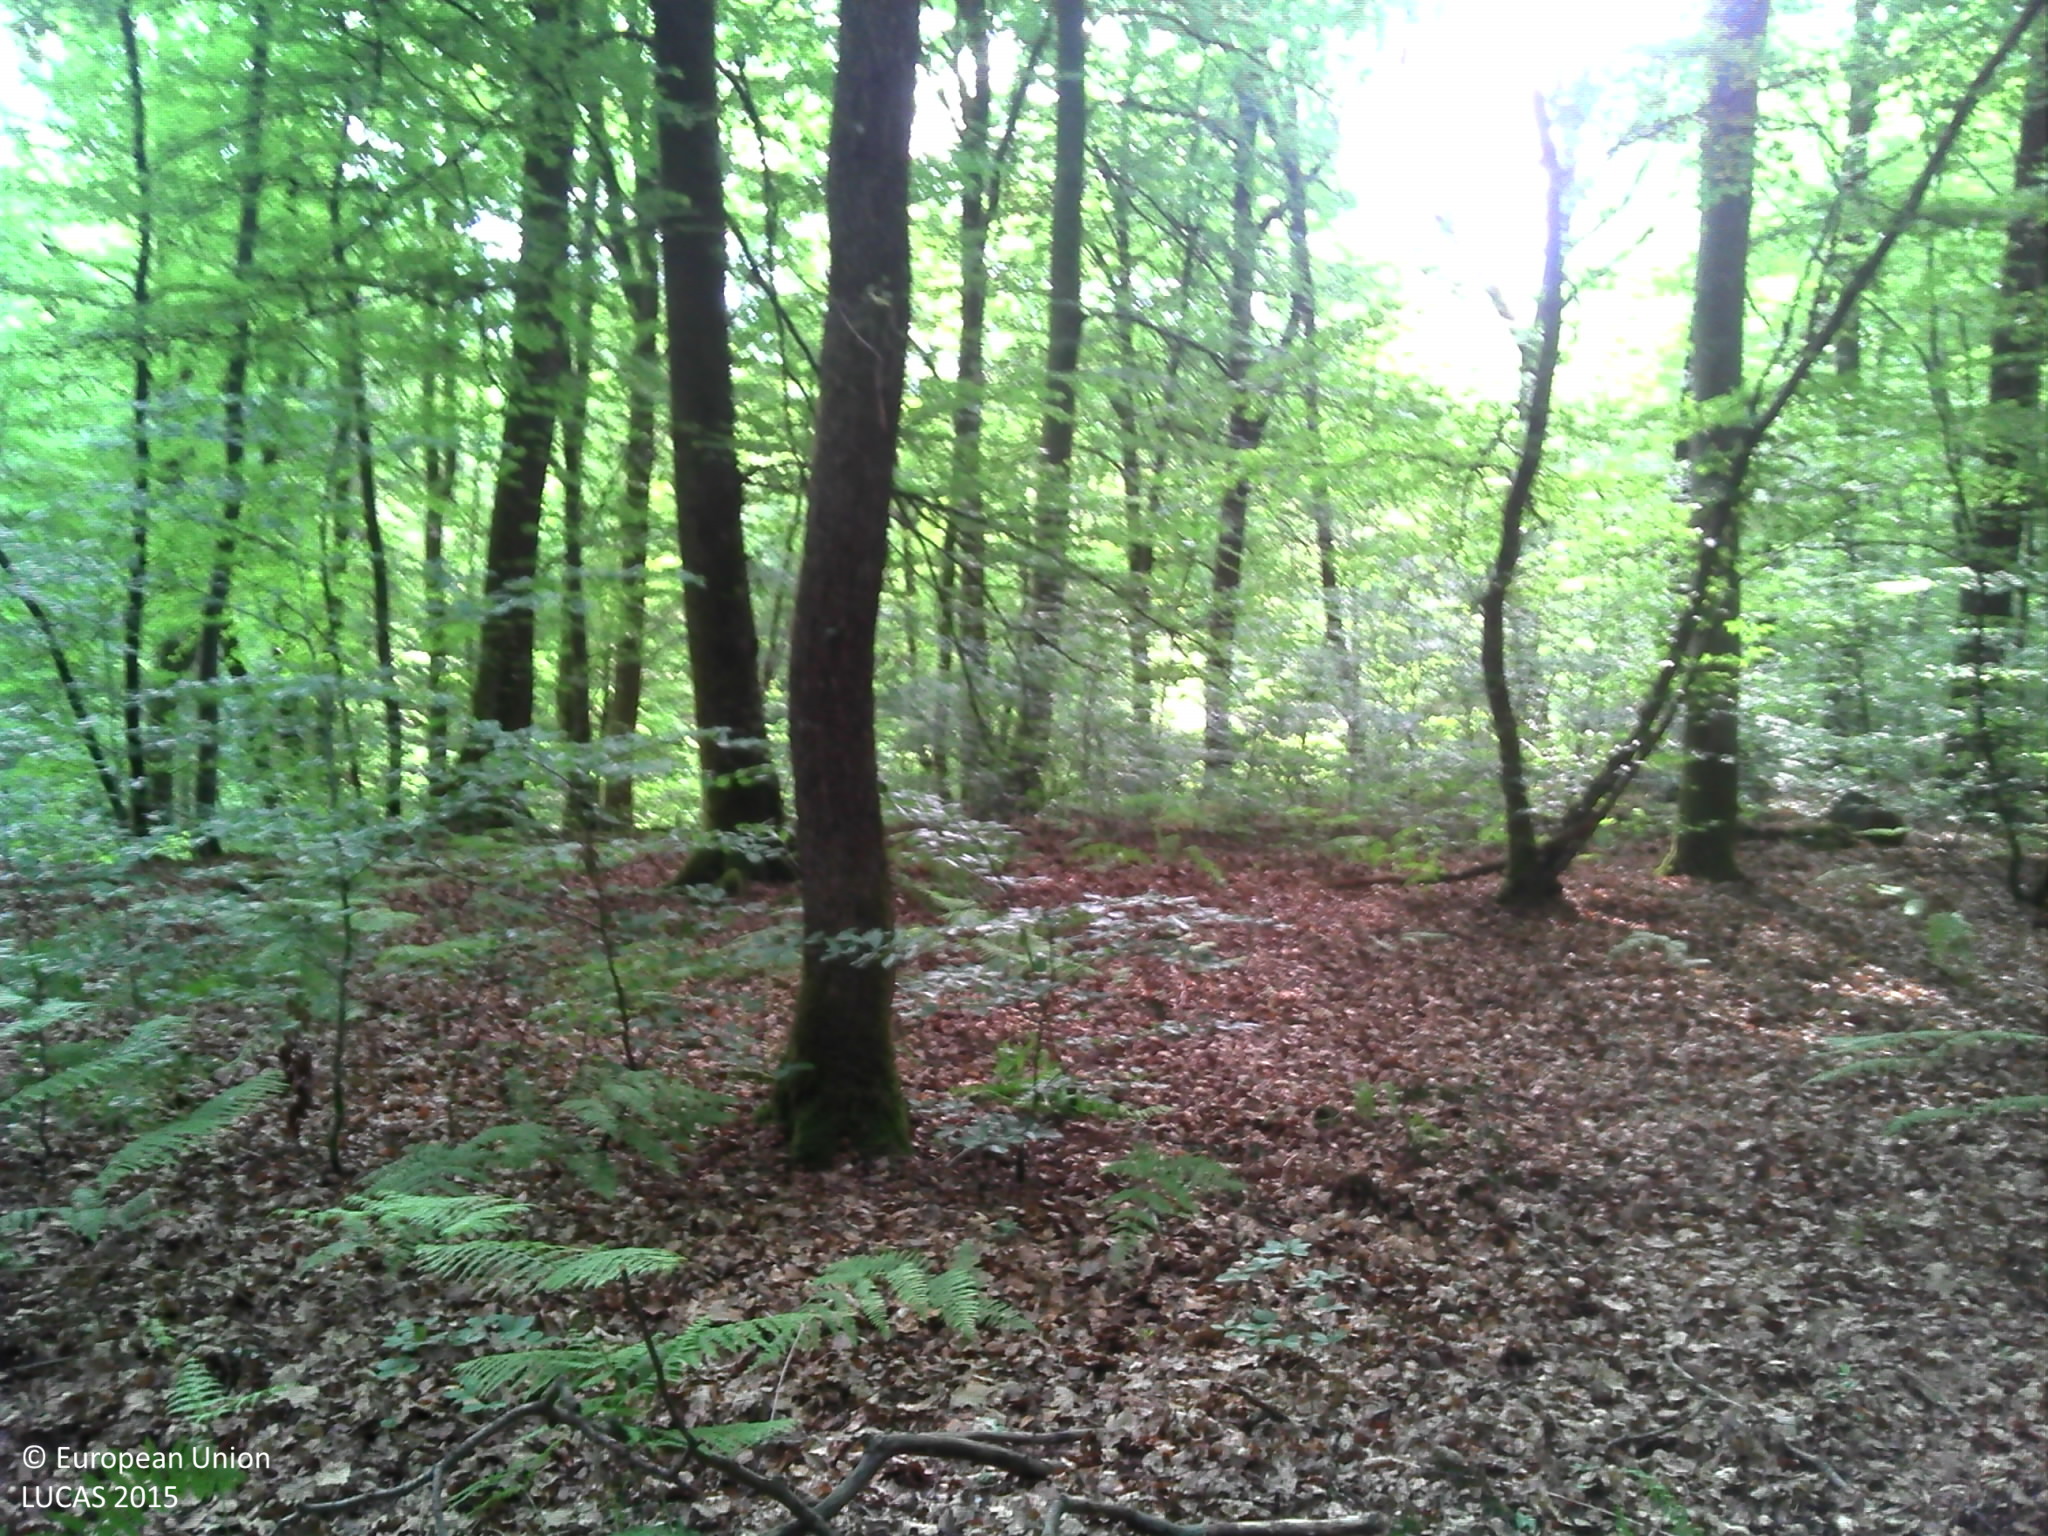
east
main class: Woodland
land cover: Broadleaved woodland
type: beech forest
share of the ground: > 75 %
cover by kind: broadleaved forest trees 95 %, herbaceous plants 5 %
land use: Forestry
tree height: > 5 m
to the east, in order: Broadleaved woodland; Spruce dominated coniferous woodland; Rivers and streams; Spruce dominated coniferous woodland; Broadleaved woodland
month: June
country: FR
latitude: 47.8308
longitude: 6.1134
